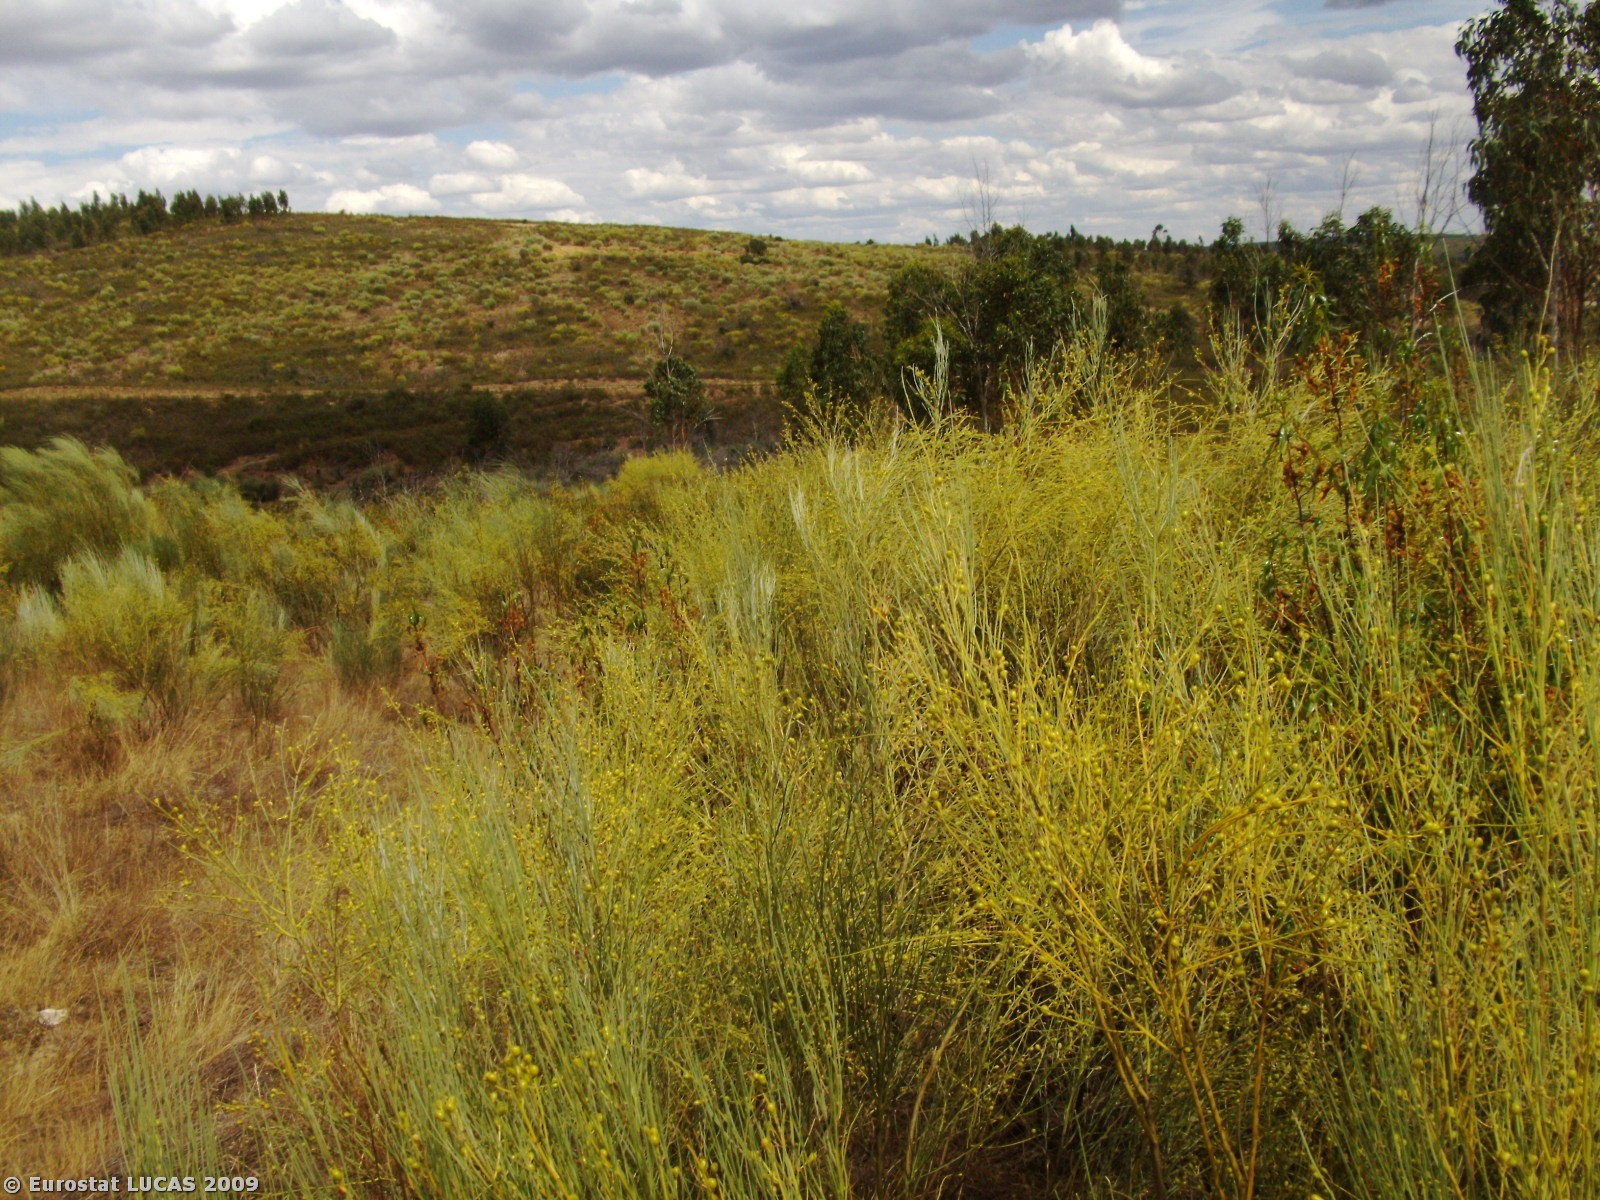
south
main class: Woodland
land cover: Broadleaved woodland
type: plantations and self-sown exotic forest
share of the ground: 25 - 50 %
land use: Forestry
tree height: > 5 m
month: June
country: PT
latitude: 39.9806
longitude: -6.9394
